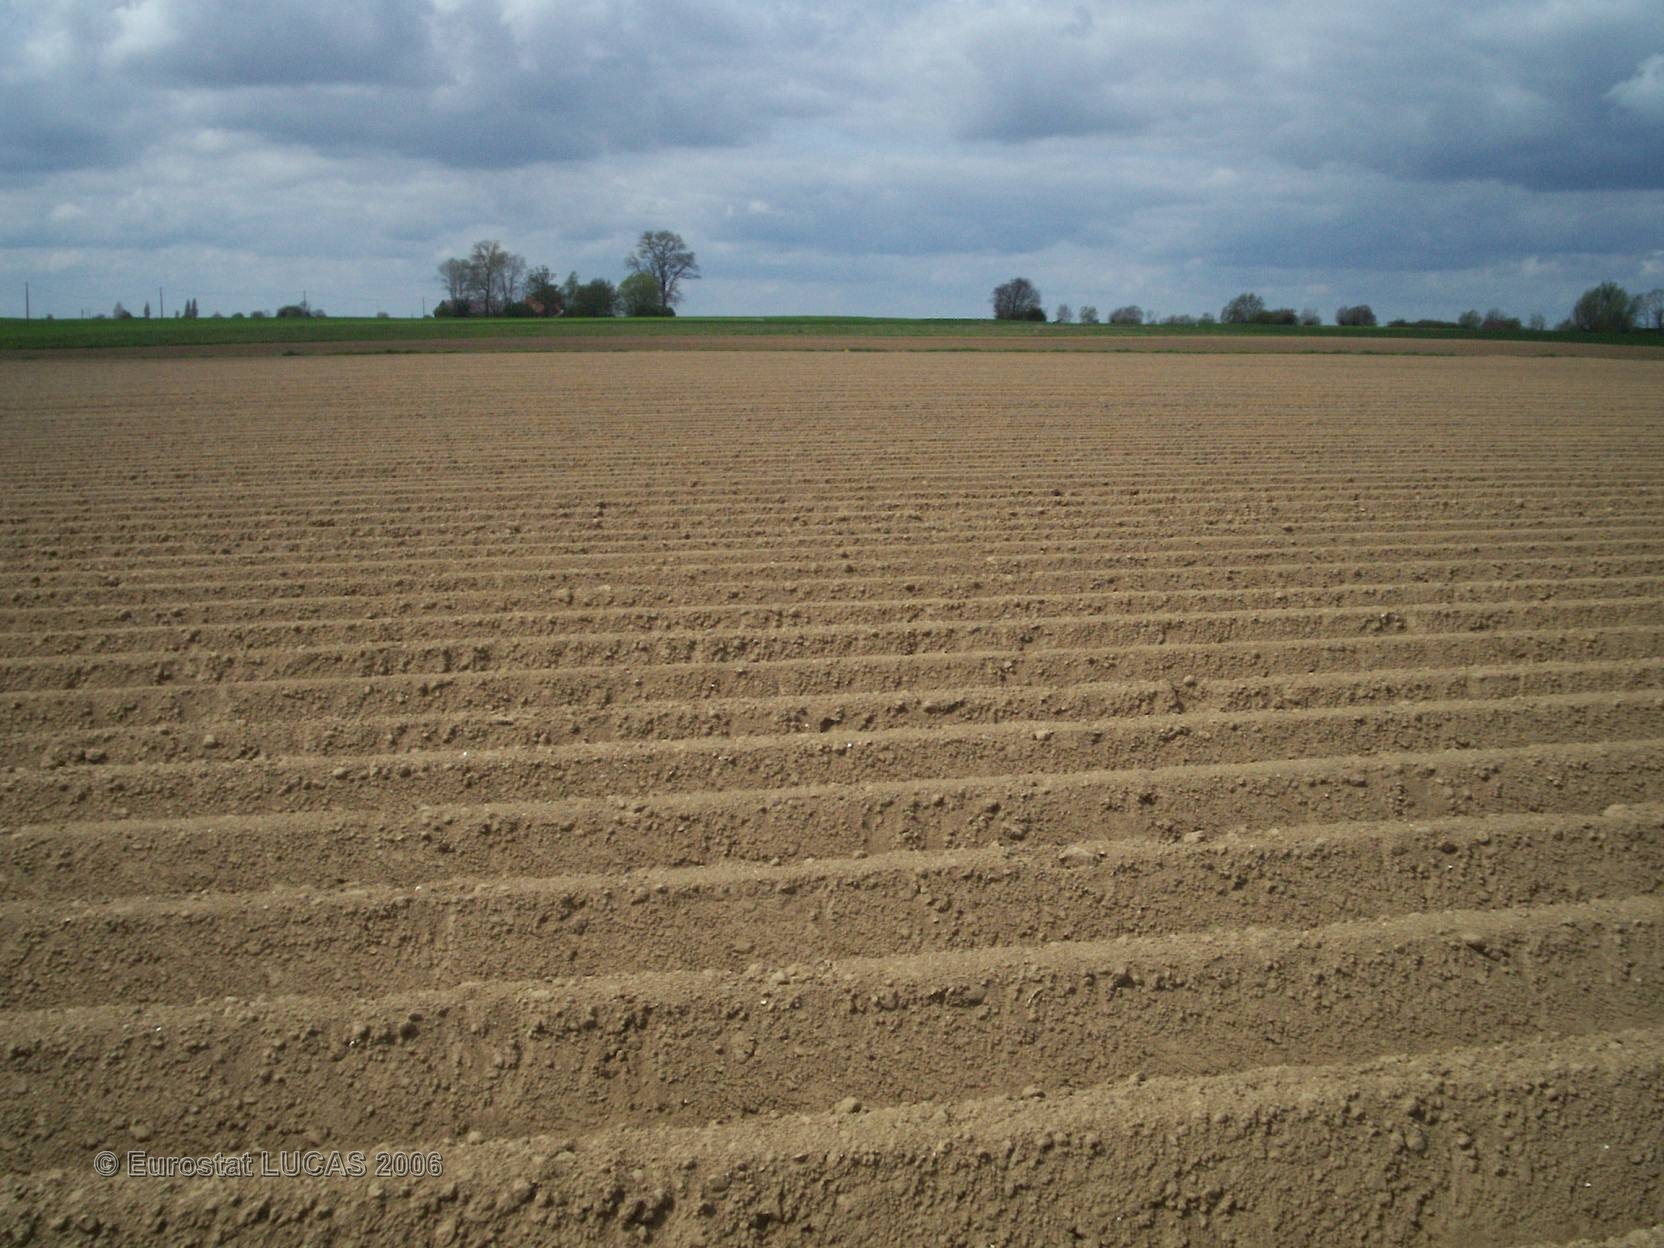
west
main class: Cropland
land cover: Potatoes
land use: Agriculture (excluding fallow land and kitchen gardens)
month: May
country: FR
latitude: 50.9154
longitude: 2.5485
